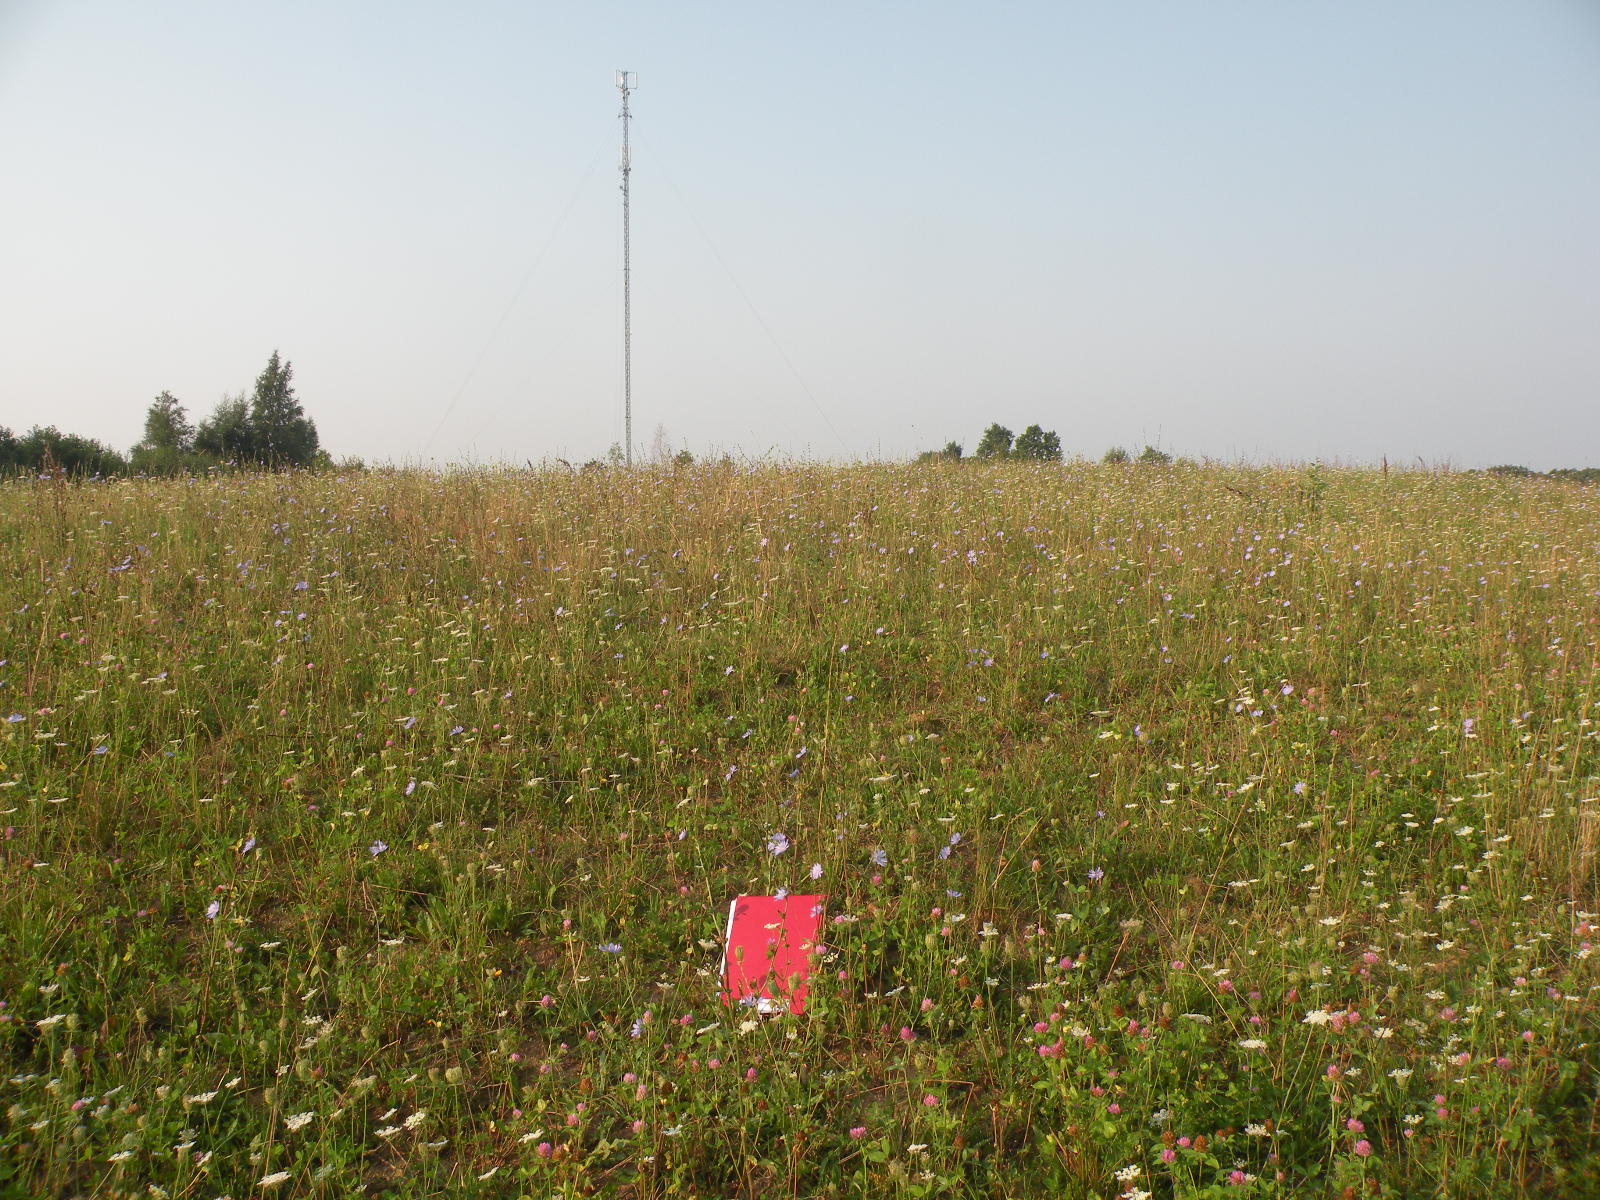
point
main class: Grassland
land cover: Grassland without tree/shrub cover
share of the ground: > 75 %
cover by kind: herbaceous plants 85 %, unconsolidated bare surface 15 %
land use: Agriculture (excluding fallow land and kitchen gardens)
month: August
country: LV
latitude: 55.7299
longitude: 26.6692
